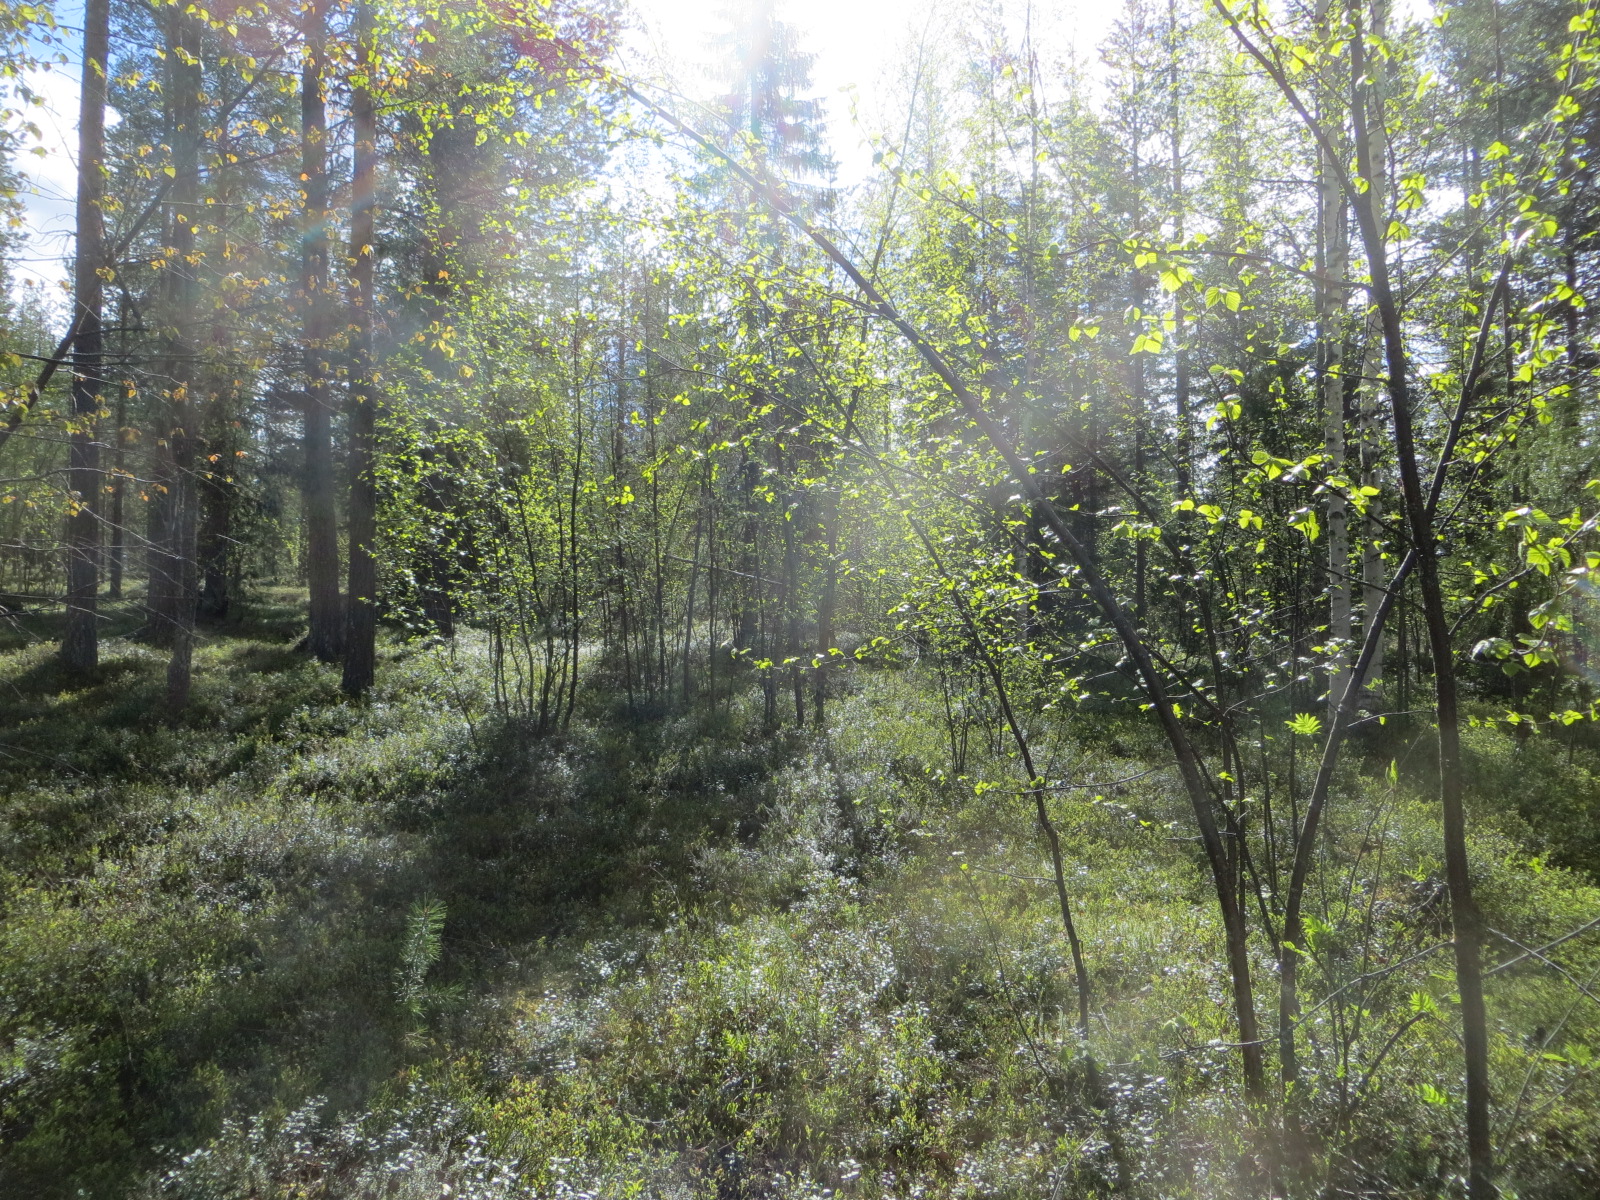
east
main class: Woodland
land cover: Pine dominated mixed woodland
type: boreal forest
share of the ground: 50 - 75 %
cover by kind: coniferous forest trees 50 %, shrubs 30 %, broadleaved forest trees 20 %
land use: Forestry
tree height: > 5 m
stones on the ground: 25 - 50 %
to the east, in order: Pine dominated mixed woodland; Tracks; Pine dominated mixed woodland; Tracks; Pine dominated mixed woodland
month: June
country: FI
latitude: 67.6149
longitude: 25.2668
